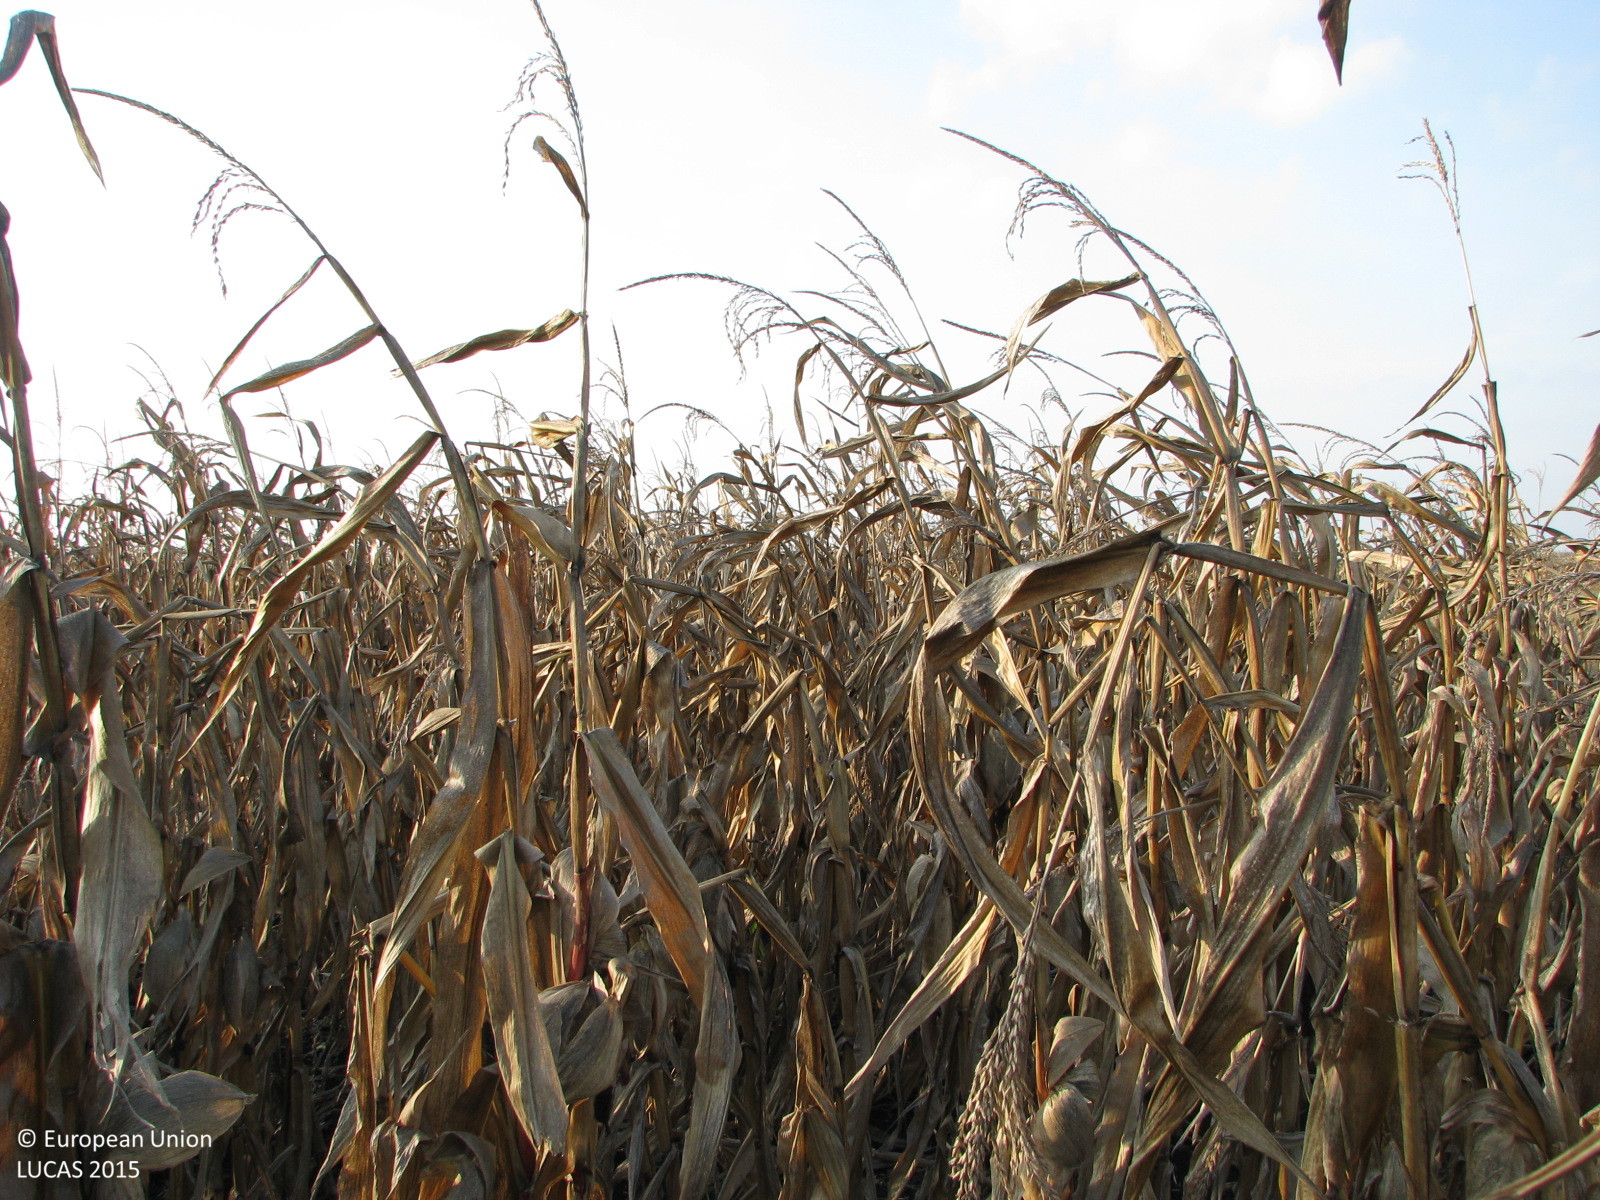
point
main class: Cropland
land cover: Maize
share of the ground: > 75 %
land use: Agriculture (excluding fallow land and kitchen gardens)
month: October
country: BG
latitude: 42.3090
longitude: 26.4544
